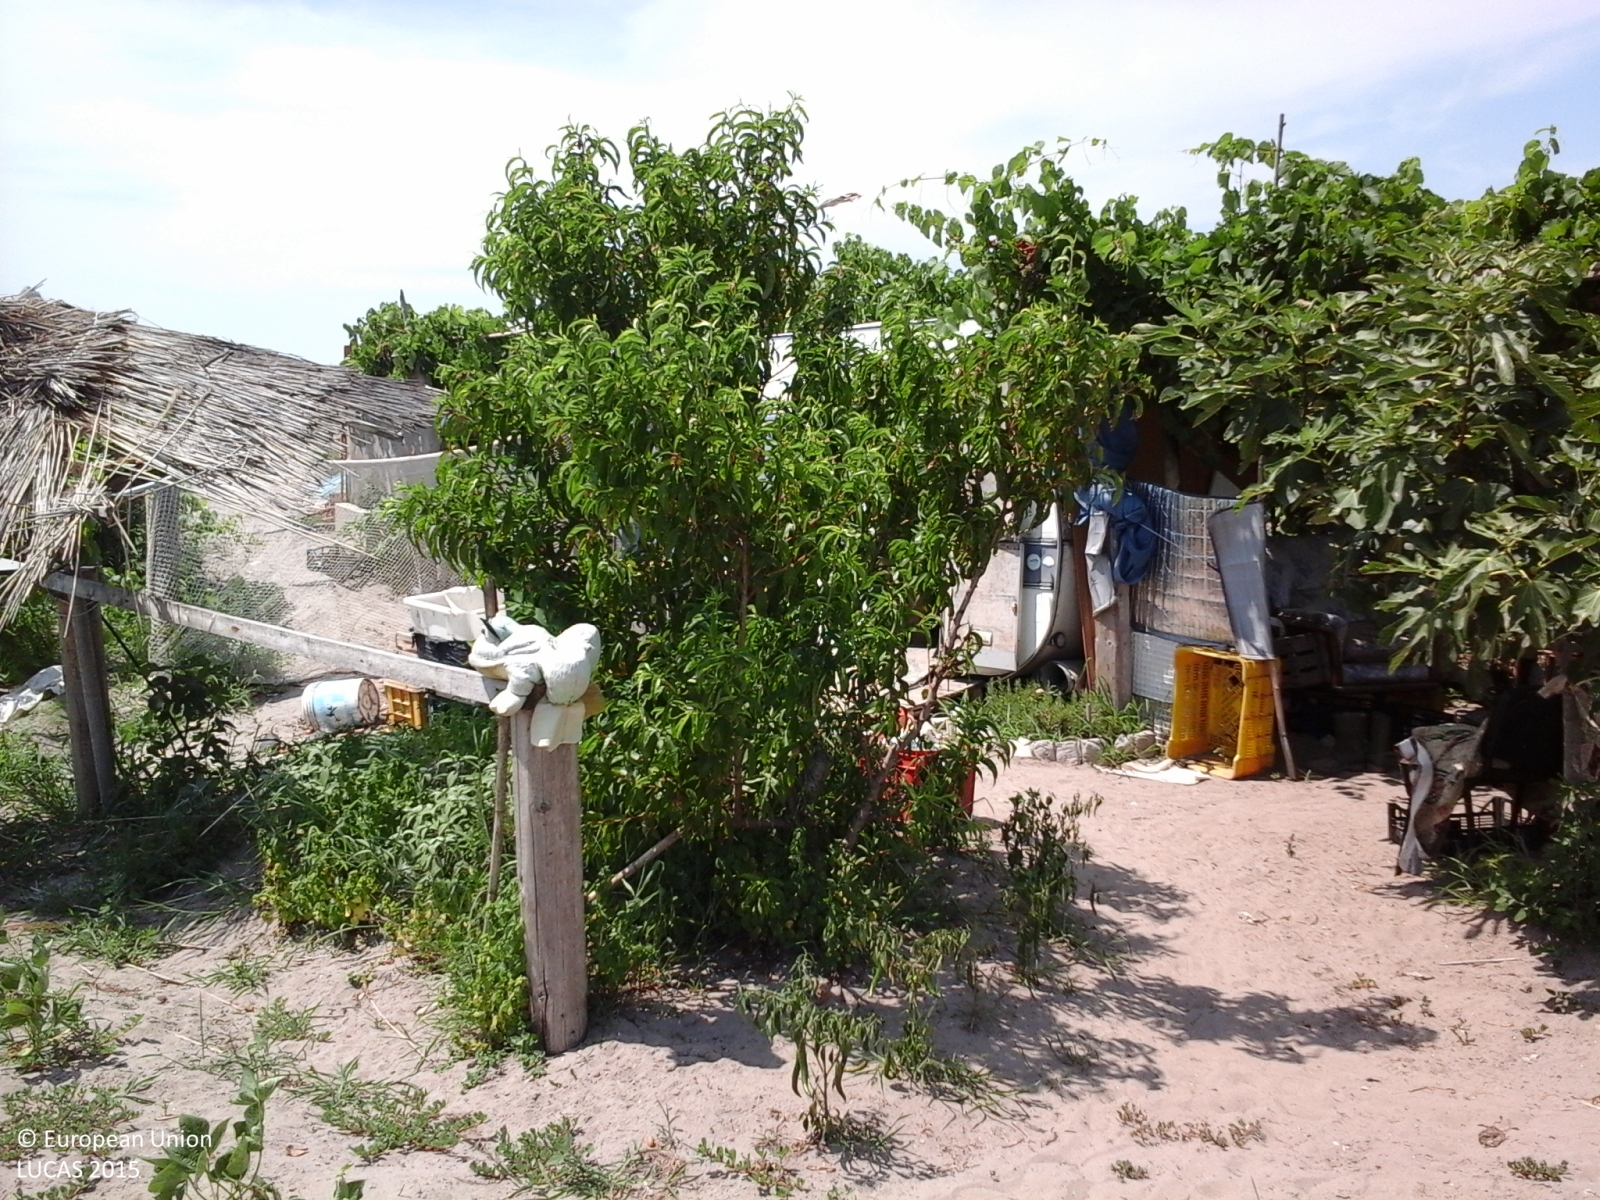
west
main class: Cropland
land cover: Other fresh vegetables
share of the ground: 10 - 25 %
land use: Agriculture (excluding fallow land and kitchen gardens)
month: July
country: IT
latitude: 45.1909
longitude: 12.2999
